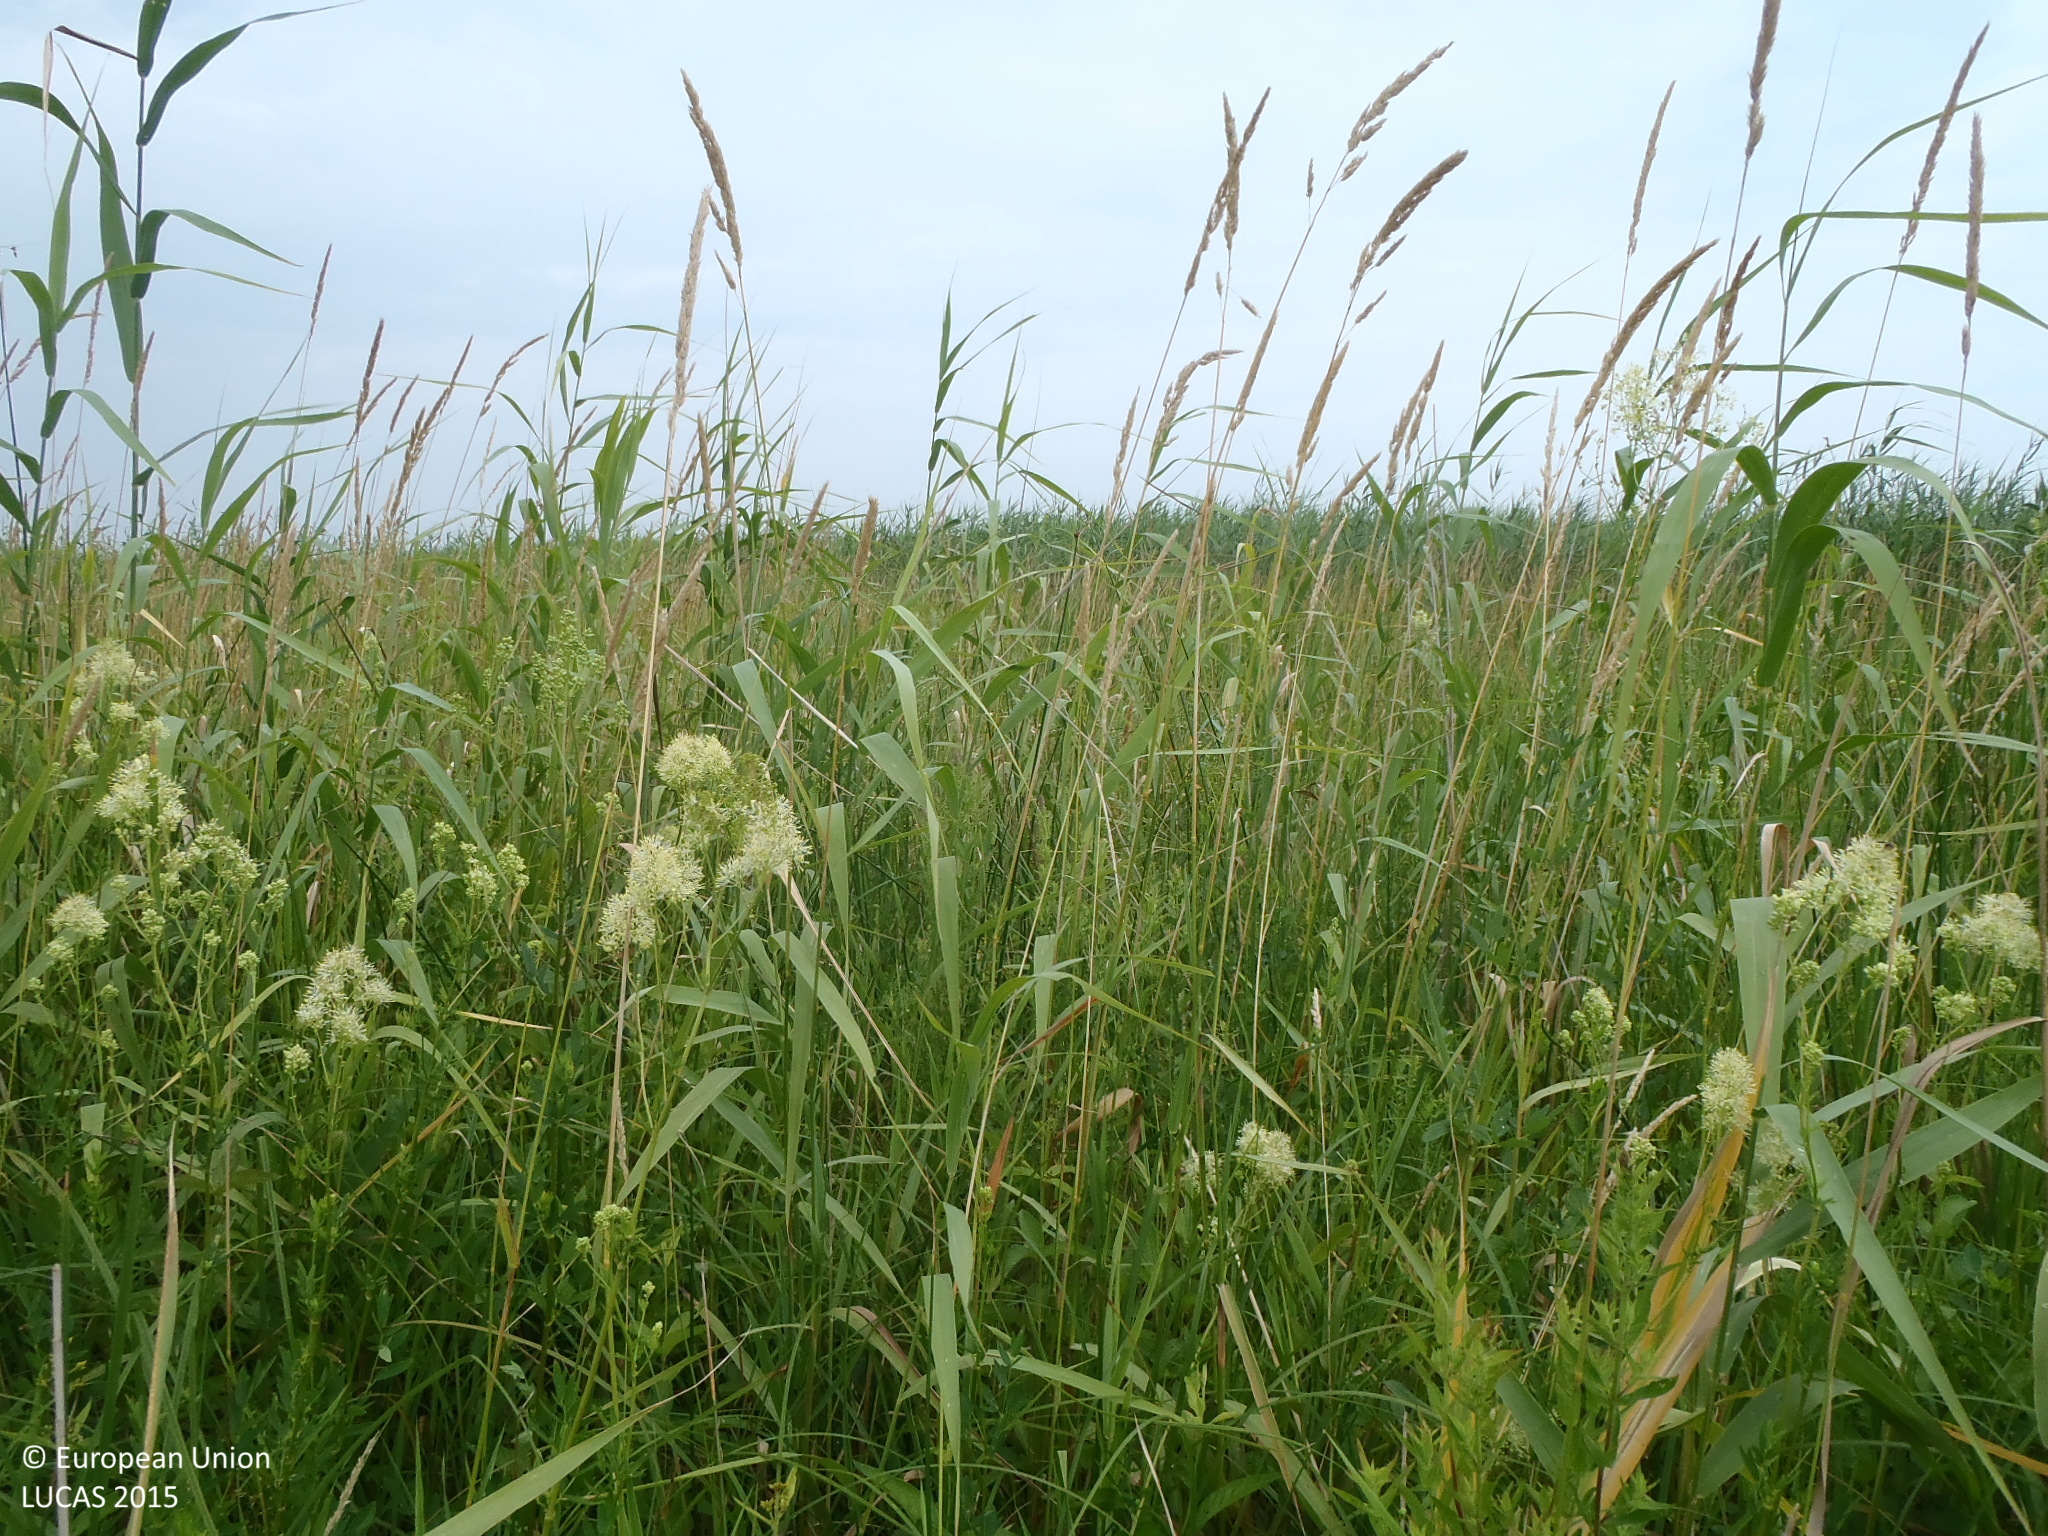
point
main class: Grassland
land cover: Spontaneously vegetated surfaces
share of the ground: > 75 %
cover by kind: herbaceous plants 95 %, shrubs 5 %
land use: Semi-natural and natural areas not in use
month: July
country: BG
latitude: 44.0016
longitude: 26.3312
